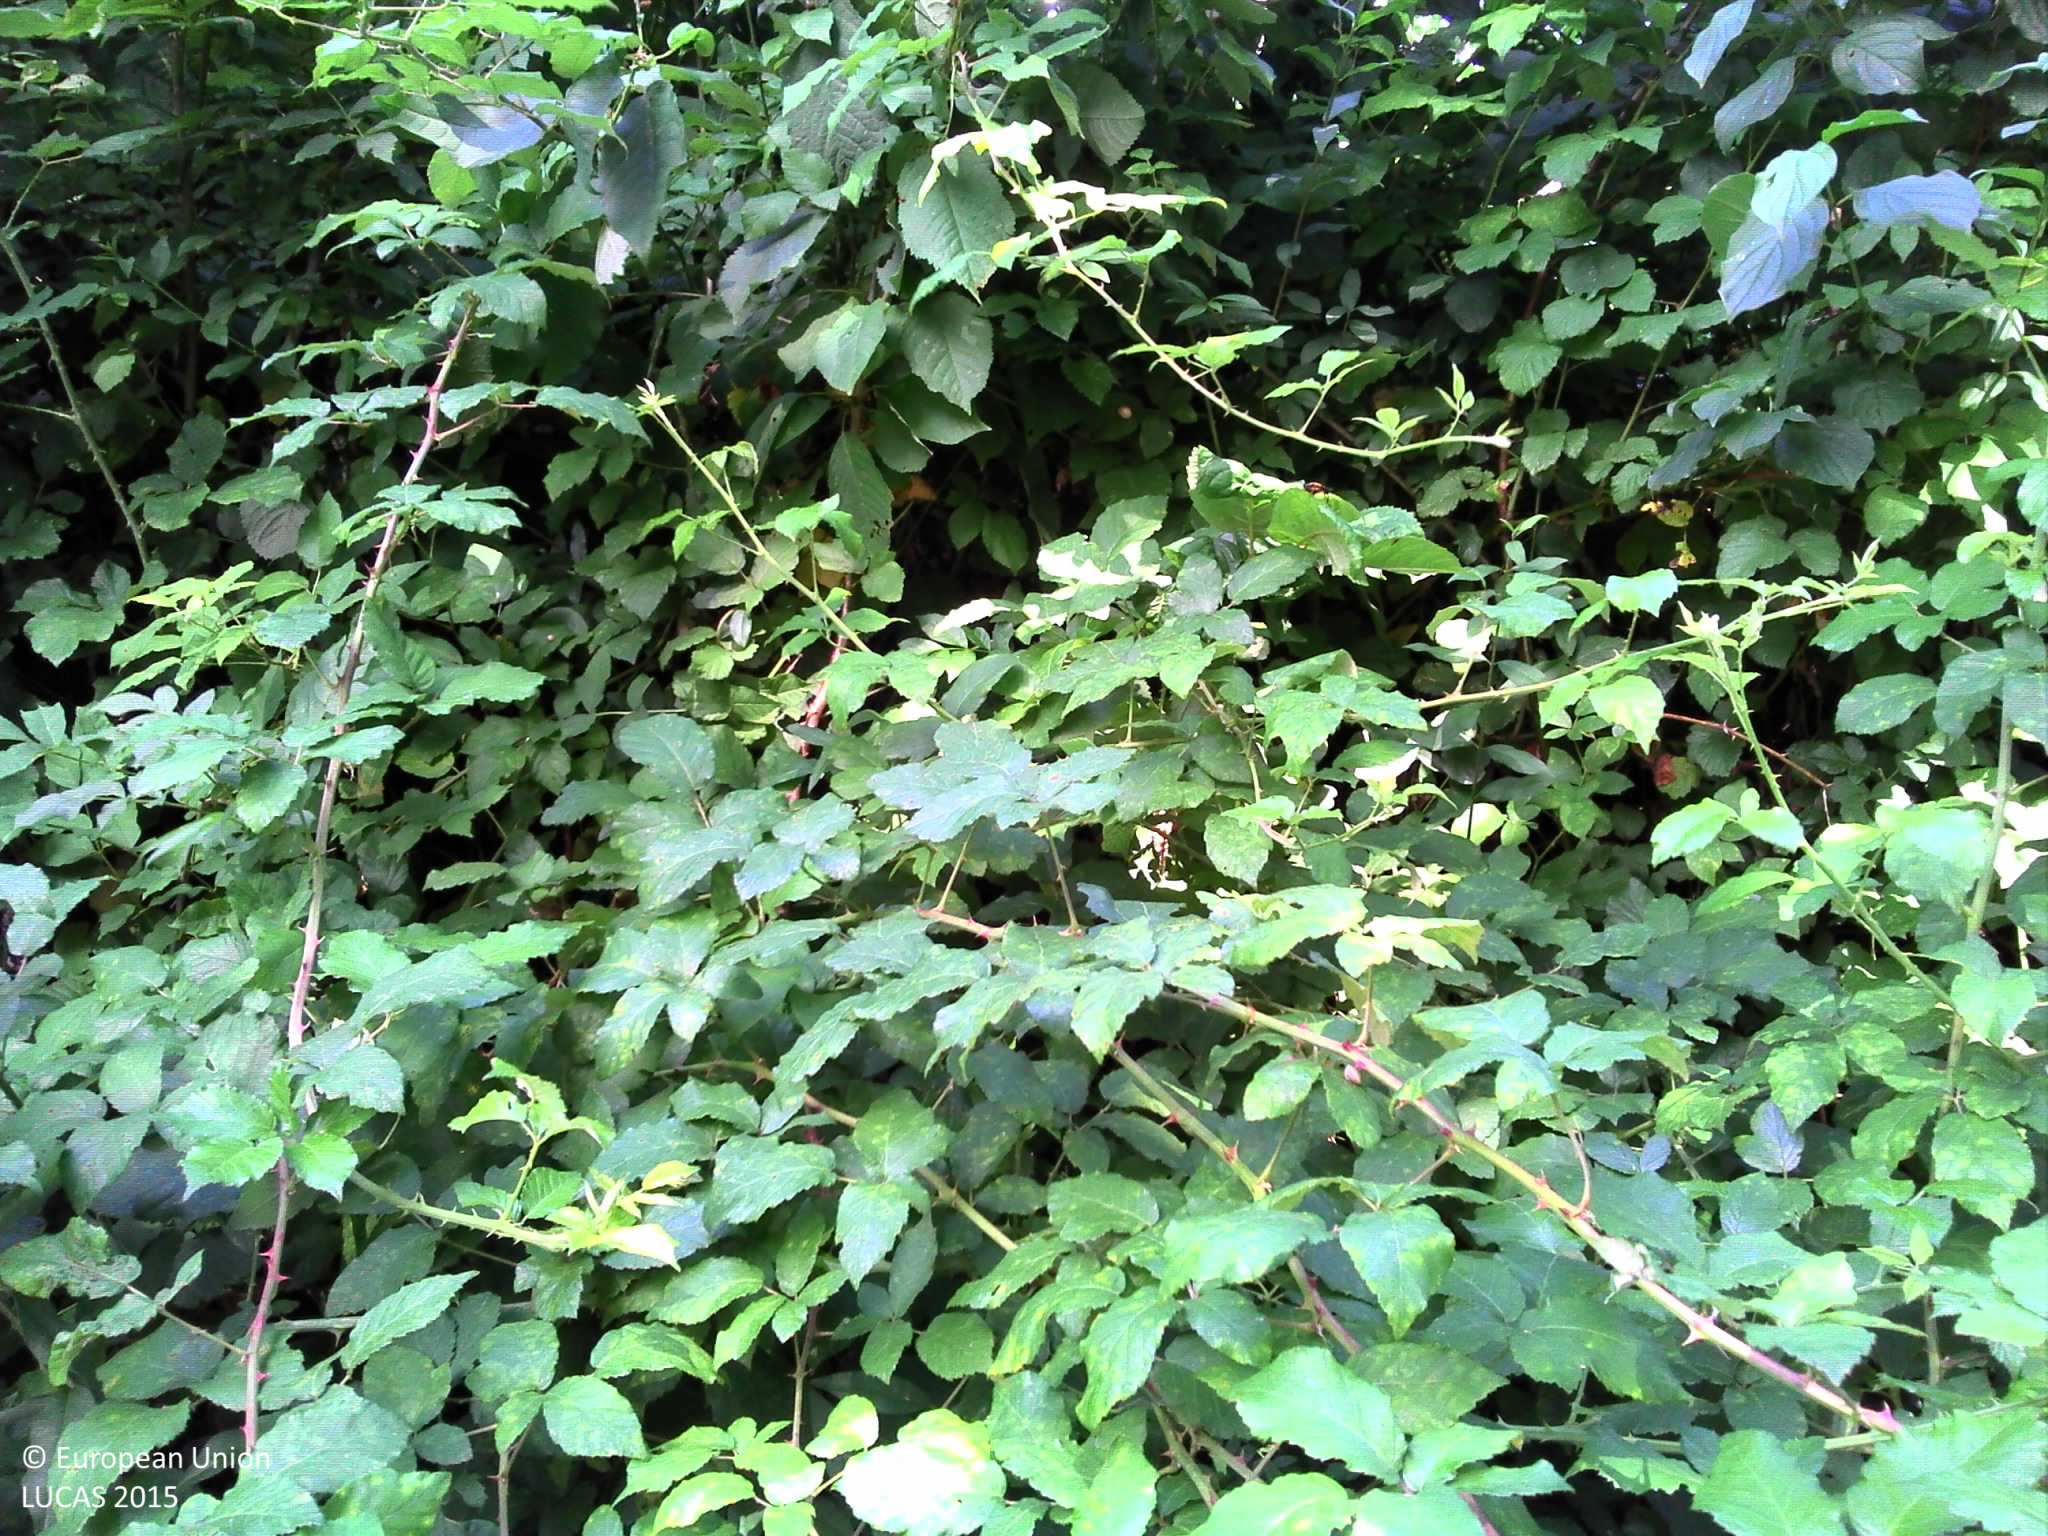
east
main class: Woodland
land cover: Broadleaved woodland
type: thermophilous deciduous forest
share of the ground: > 75 %
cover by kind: broadleaved forest trees 65 %, shrubs 30 %, herbaceous plants 5 %
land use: Forestry
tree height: > 5 m
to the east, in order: Broadleaved woodland; Fences; Grassland without tree/shrub cover
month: June
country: FR
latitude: 45.6846
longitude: 0.4200
